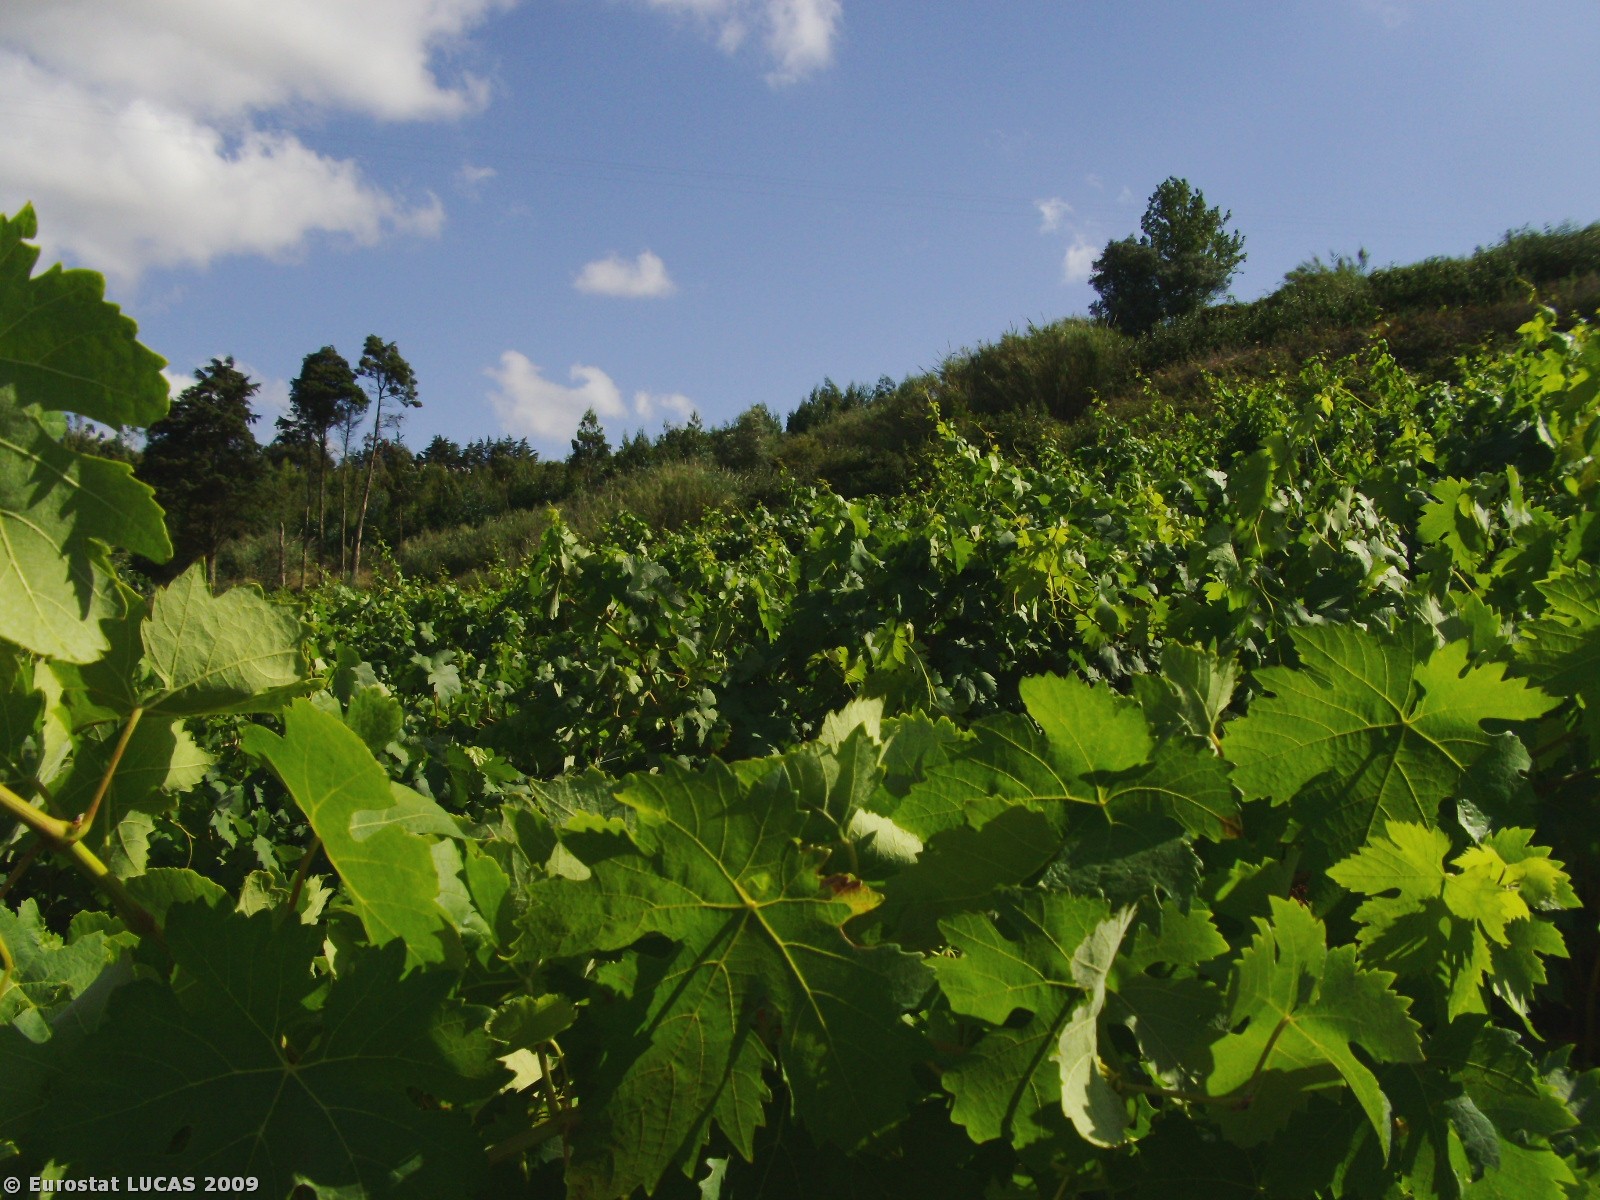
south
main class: Cropland
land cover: Vineyards
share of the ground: 50 - 75 %
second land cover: Bare land
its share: 25 - 50 %
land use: Agriculture (excluding fallow land and kitchen gardens)
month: July
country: PT
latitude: 39.0444
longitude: -9.2531
